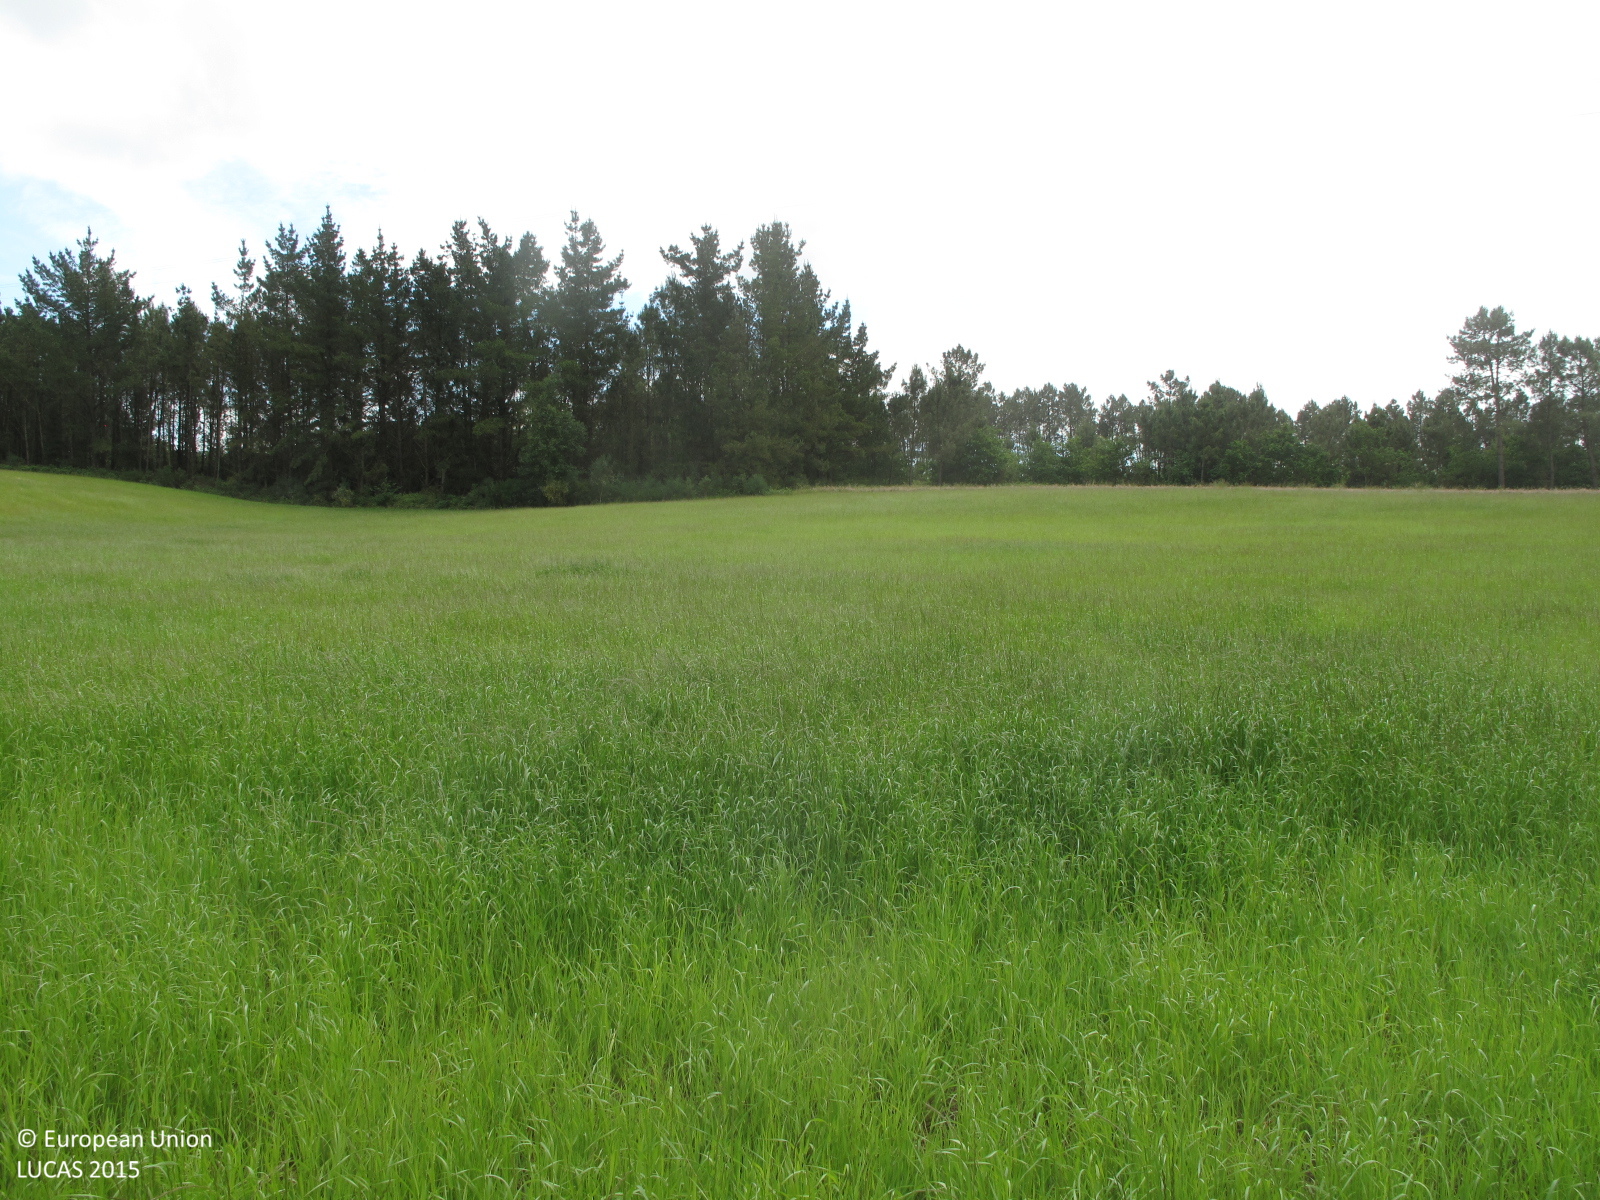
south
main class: Grassland
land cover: Grassland without tree/shrub cover
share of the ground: > 75 %
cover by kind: herbaceous plants 100 %
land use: Agriculture (excluding fallow land and kitchen gardens)
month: June
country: ES
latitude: 43.0202
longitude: -8.4991
